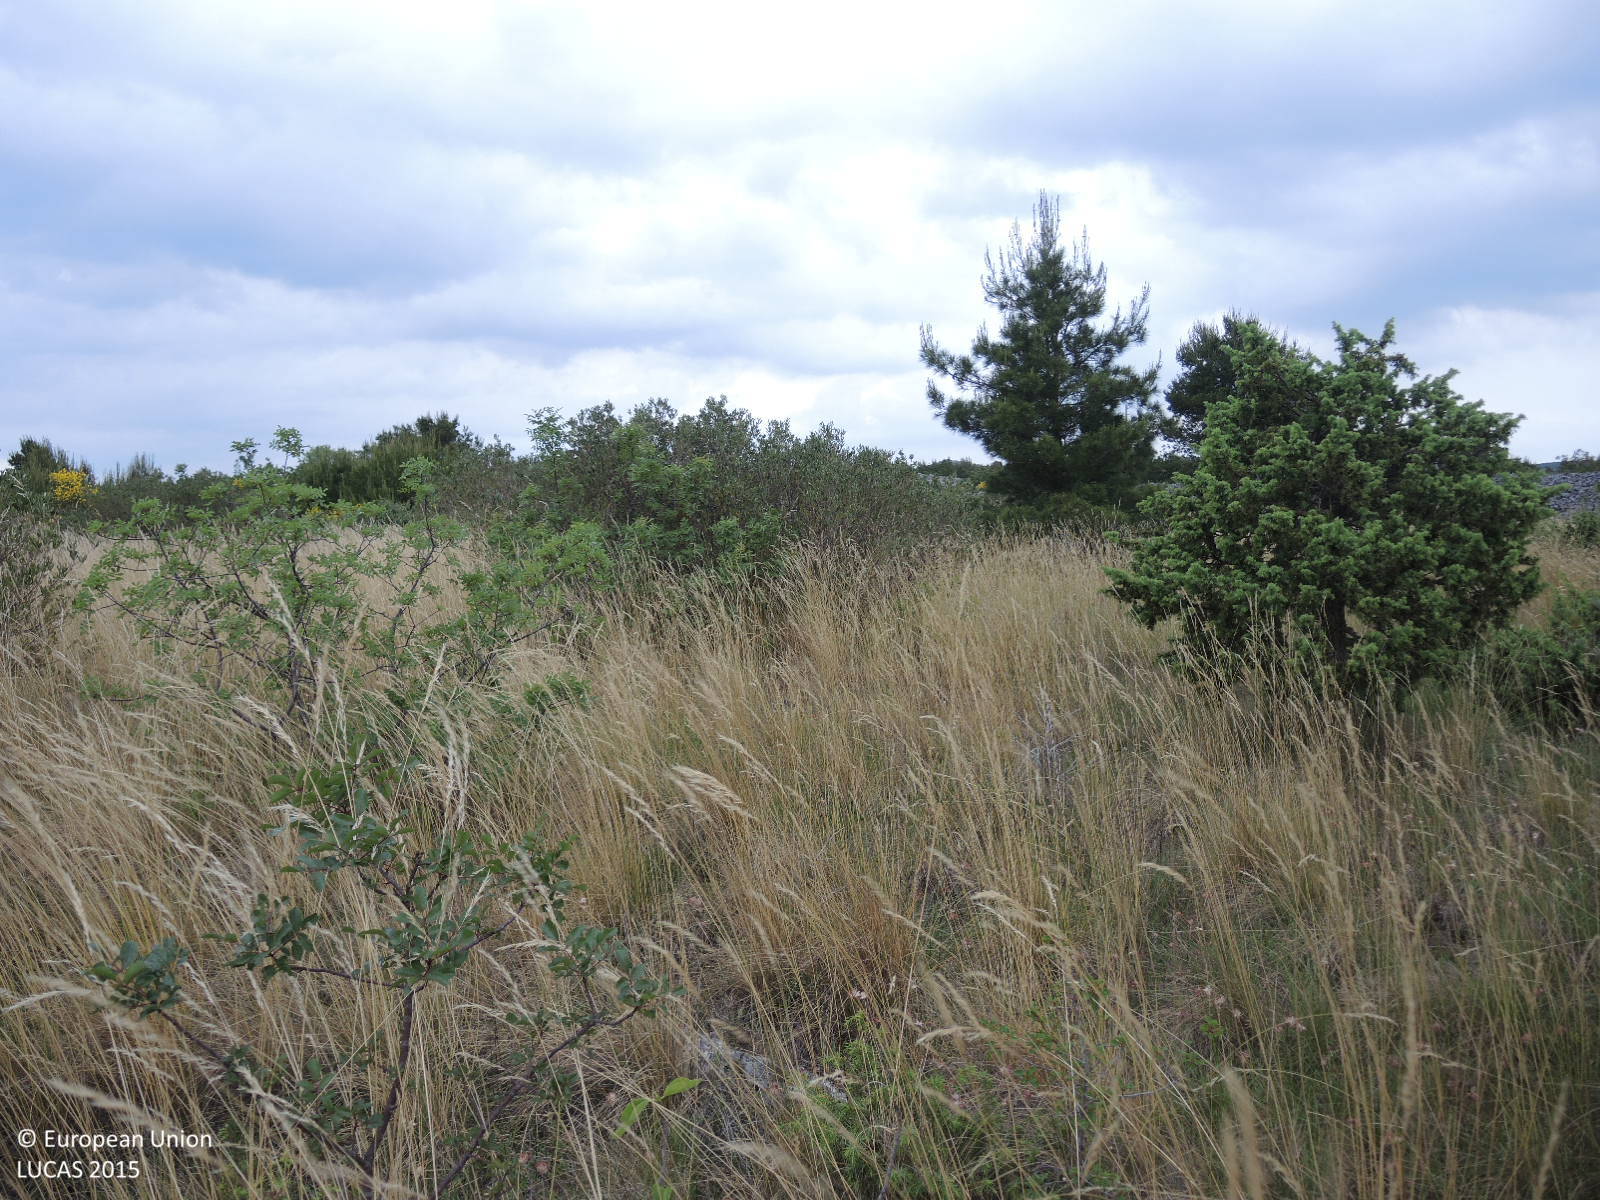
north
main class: Cropland
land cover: Olive groves
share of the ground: 10 - 25 %
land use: Agriculture (excluding fallow land and kitchen gardens)
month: May
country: HR
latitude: 43.7535
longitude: 15.8158
